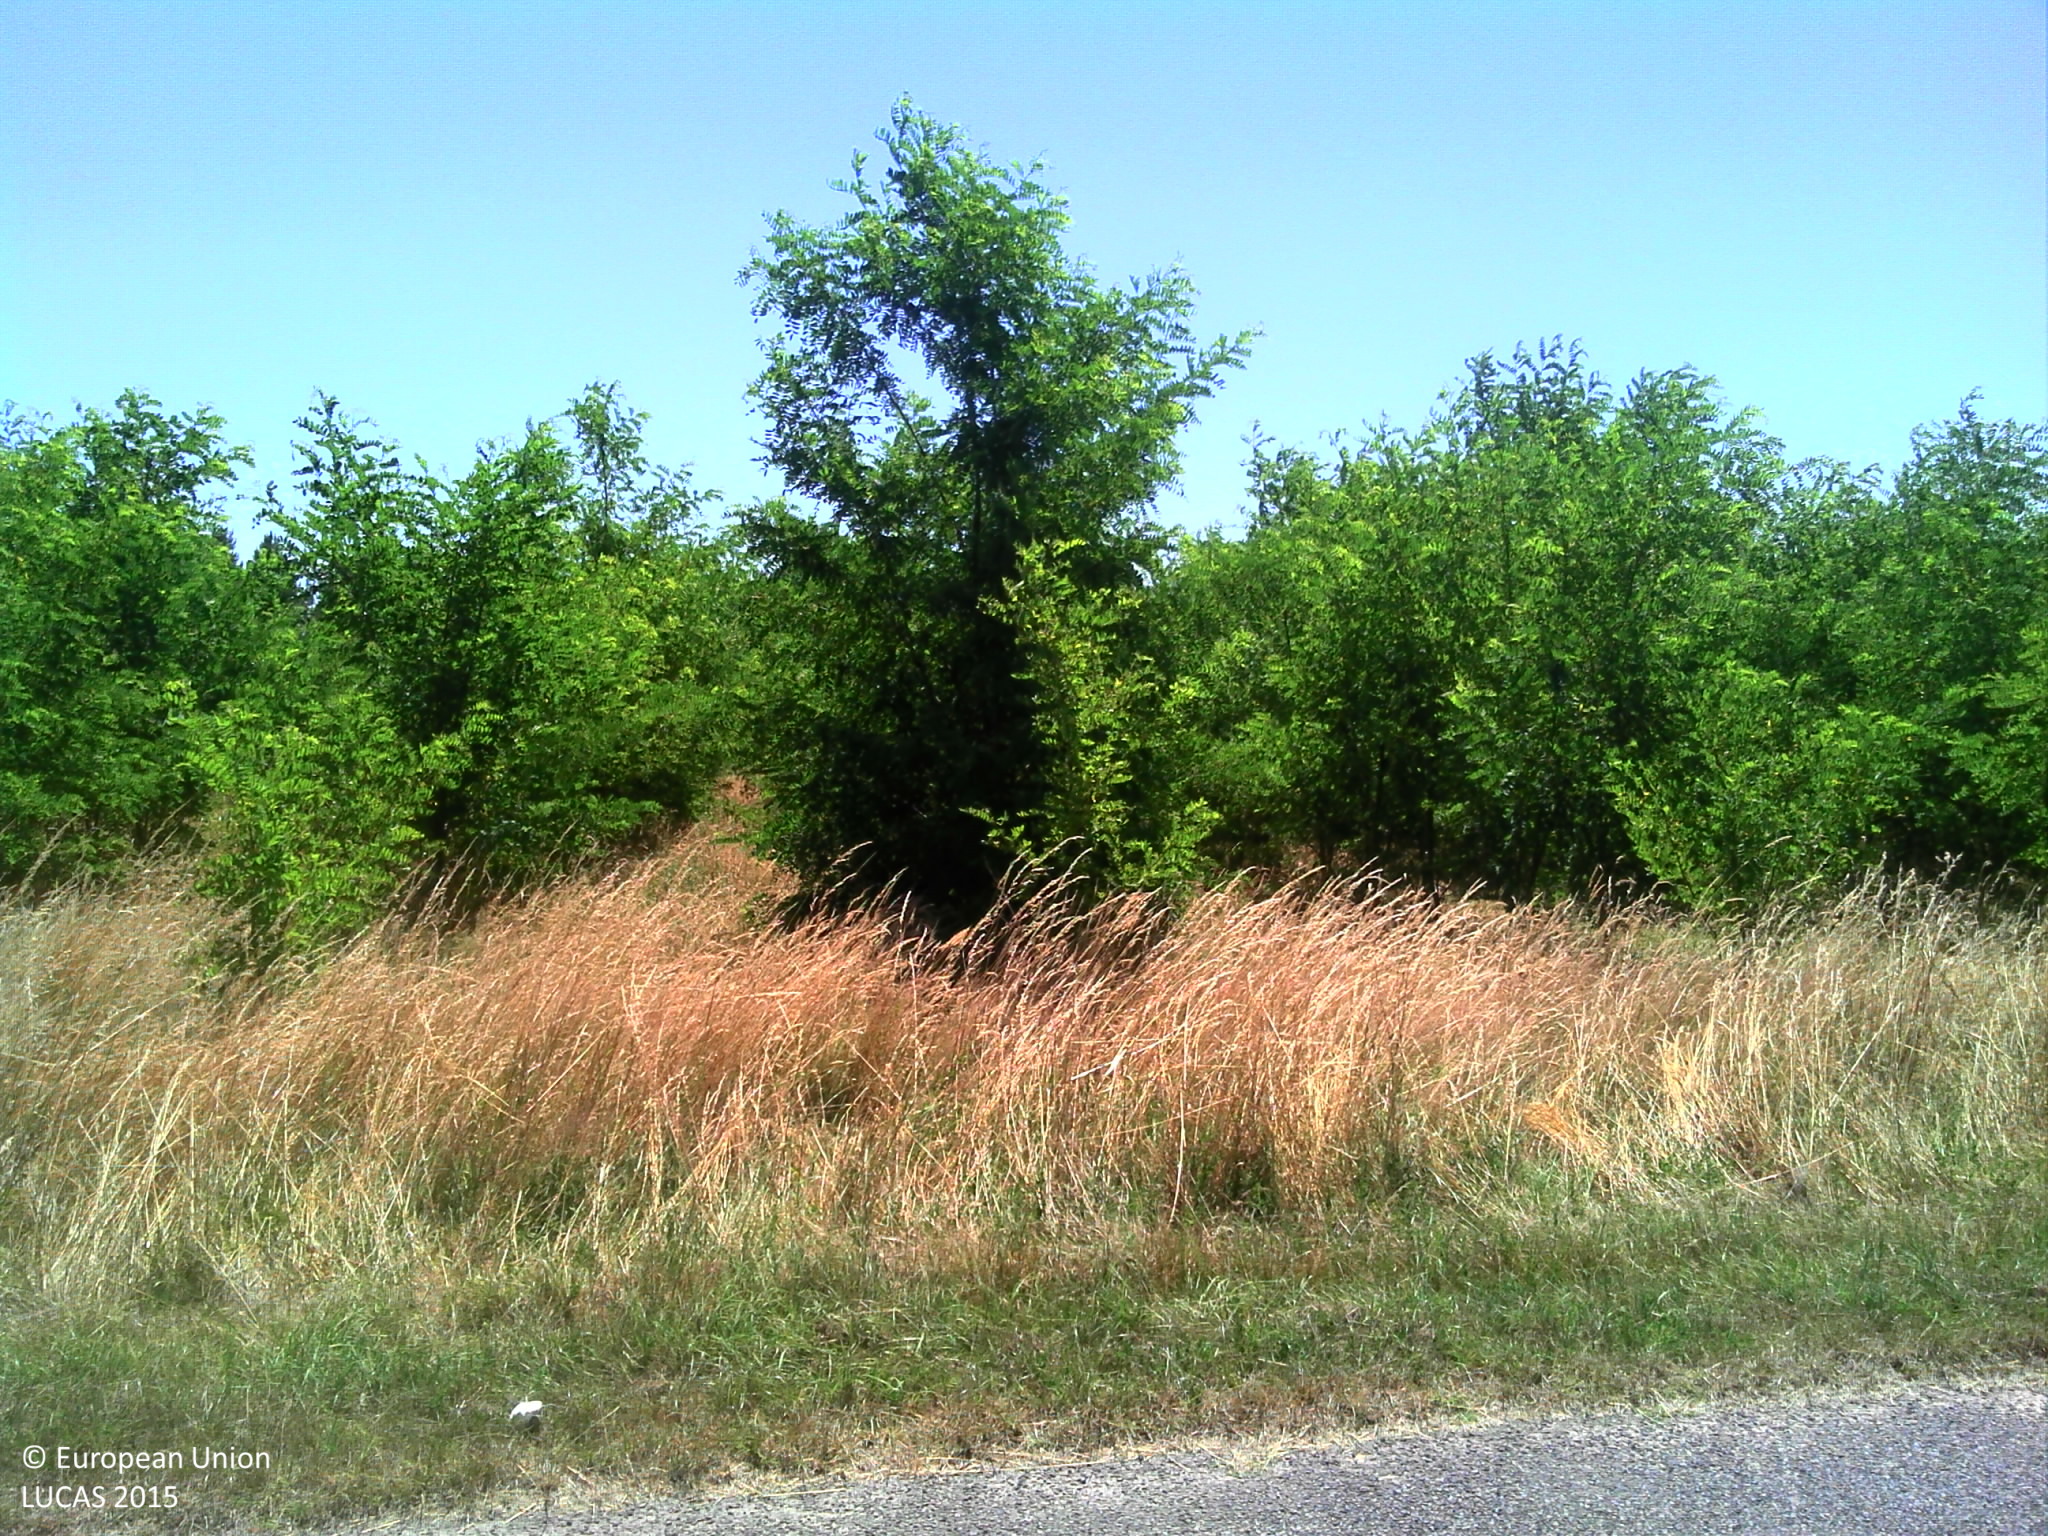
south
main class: Grassland
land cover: Grassland without tree/shrub cover
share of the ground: > 75 %
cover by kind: herbaceous plants 100 %
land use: Agriculture (excluding fallow land and kitchen gardens)
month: June
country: FR
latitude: 47.3869
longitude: 0.4006
